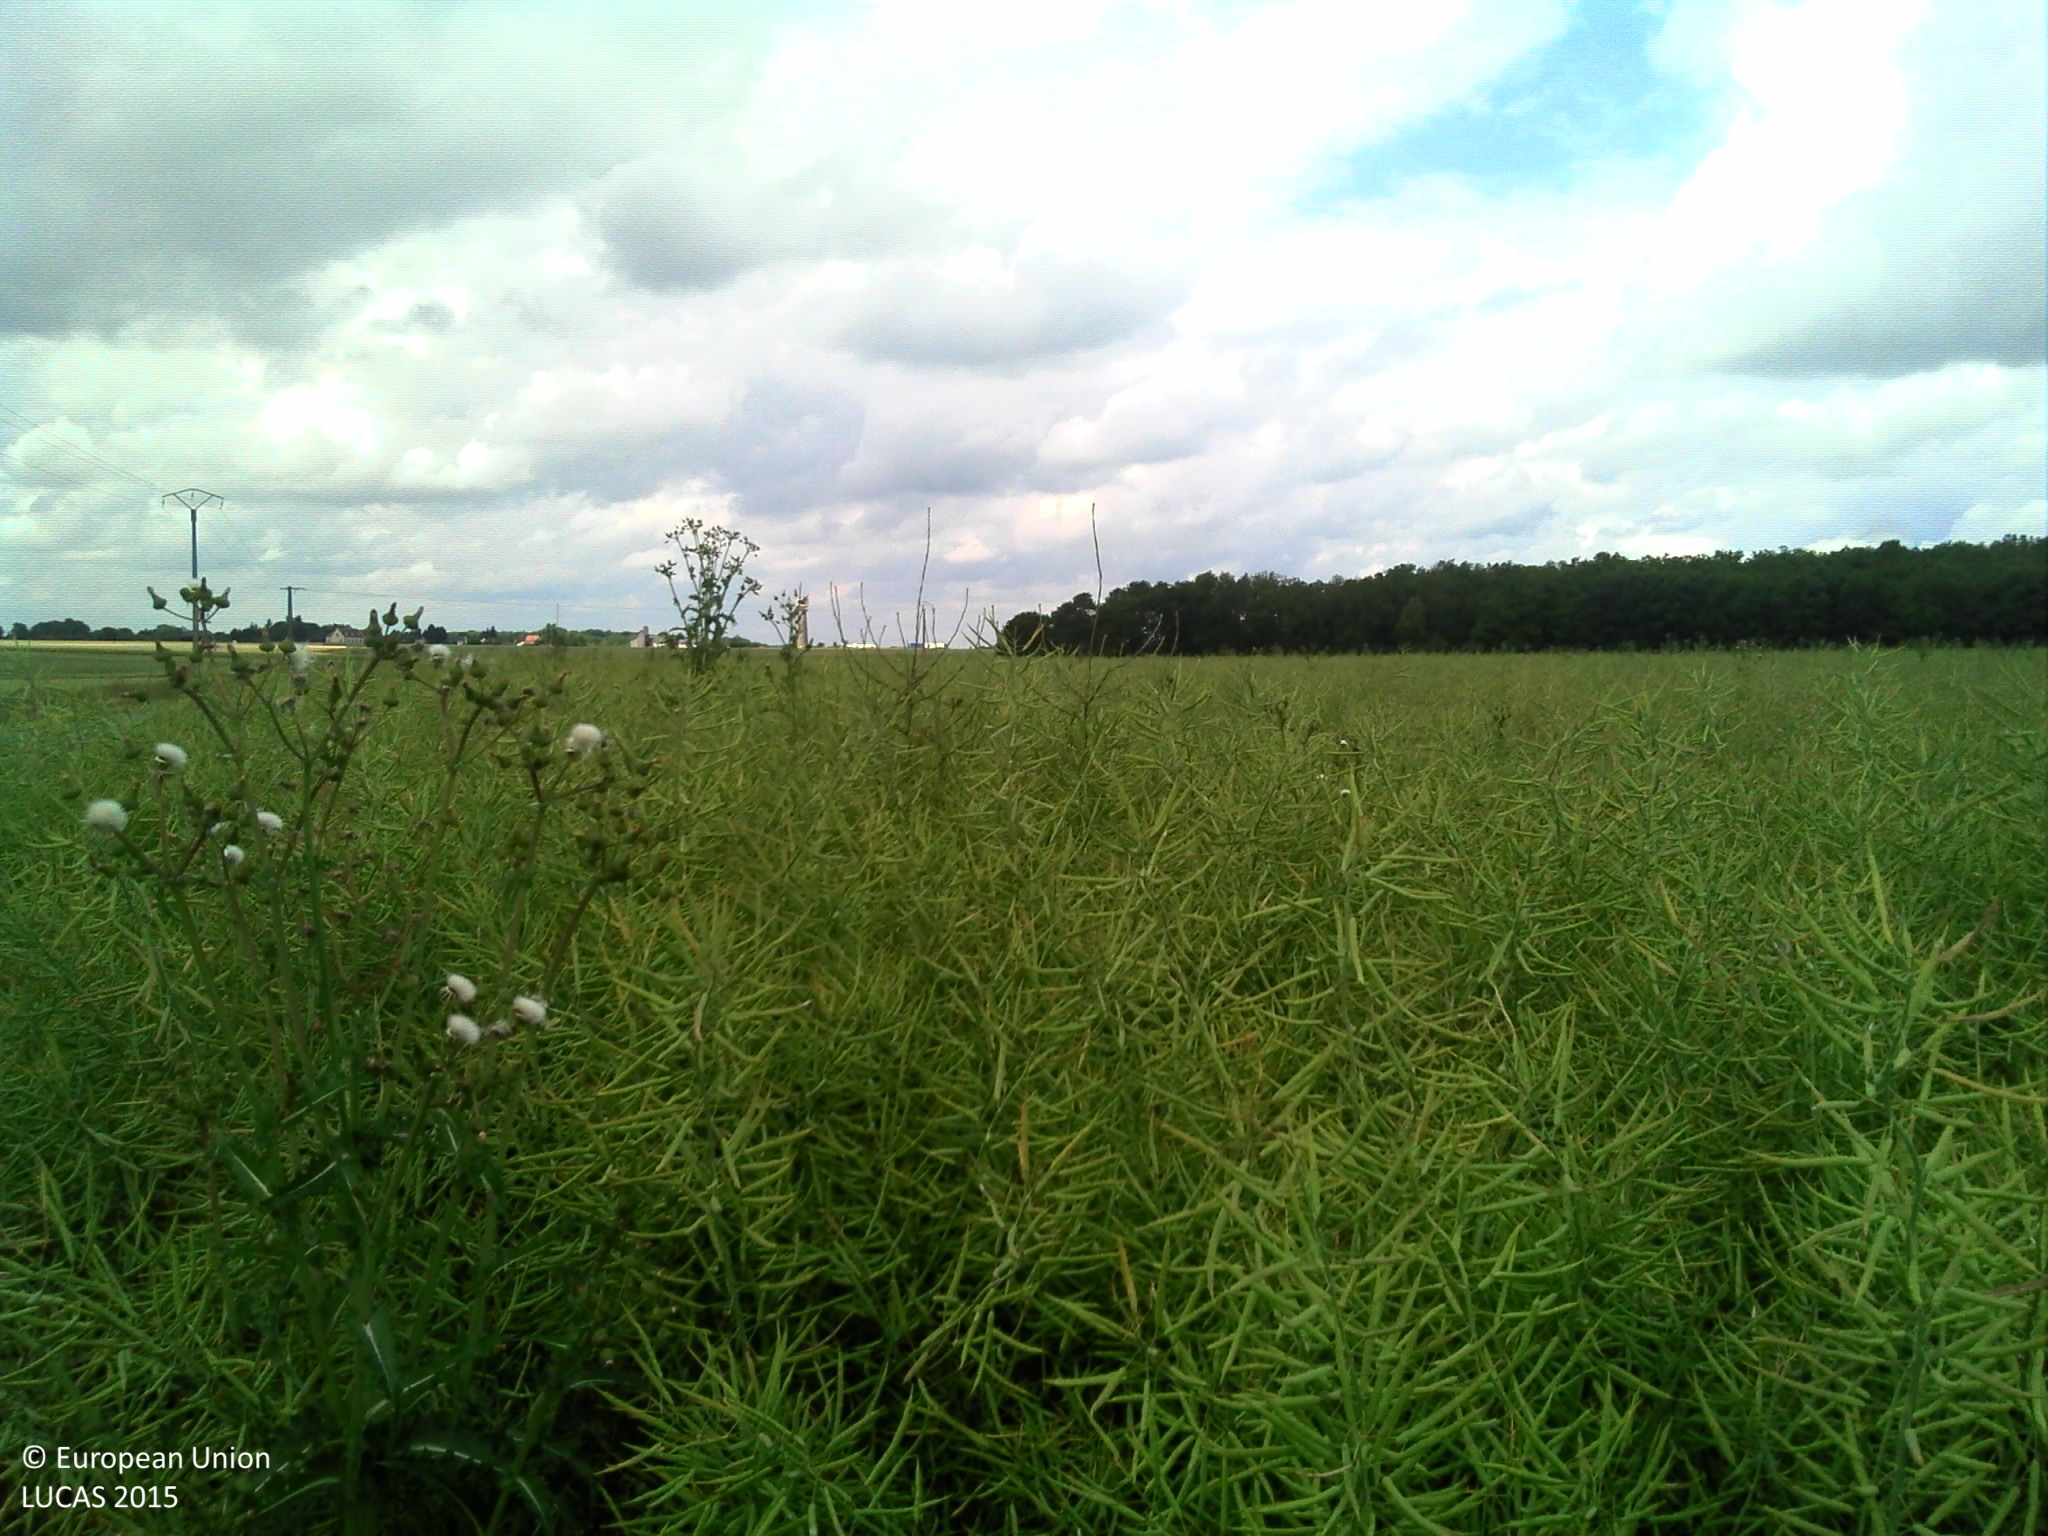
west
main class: Cropland
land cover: Rape and turnip rape
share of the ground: > 75 %
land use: Agriculture (excluding fallow land and kitchen gardens)
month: June
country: FR
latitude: 48.3248
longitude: 1.4457
